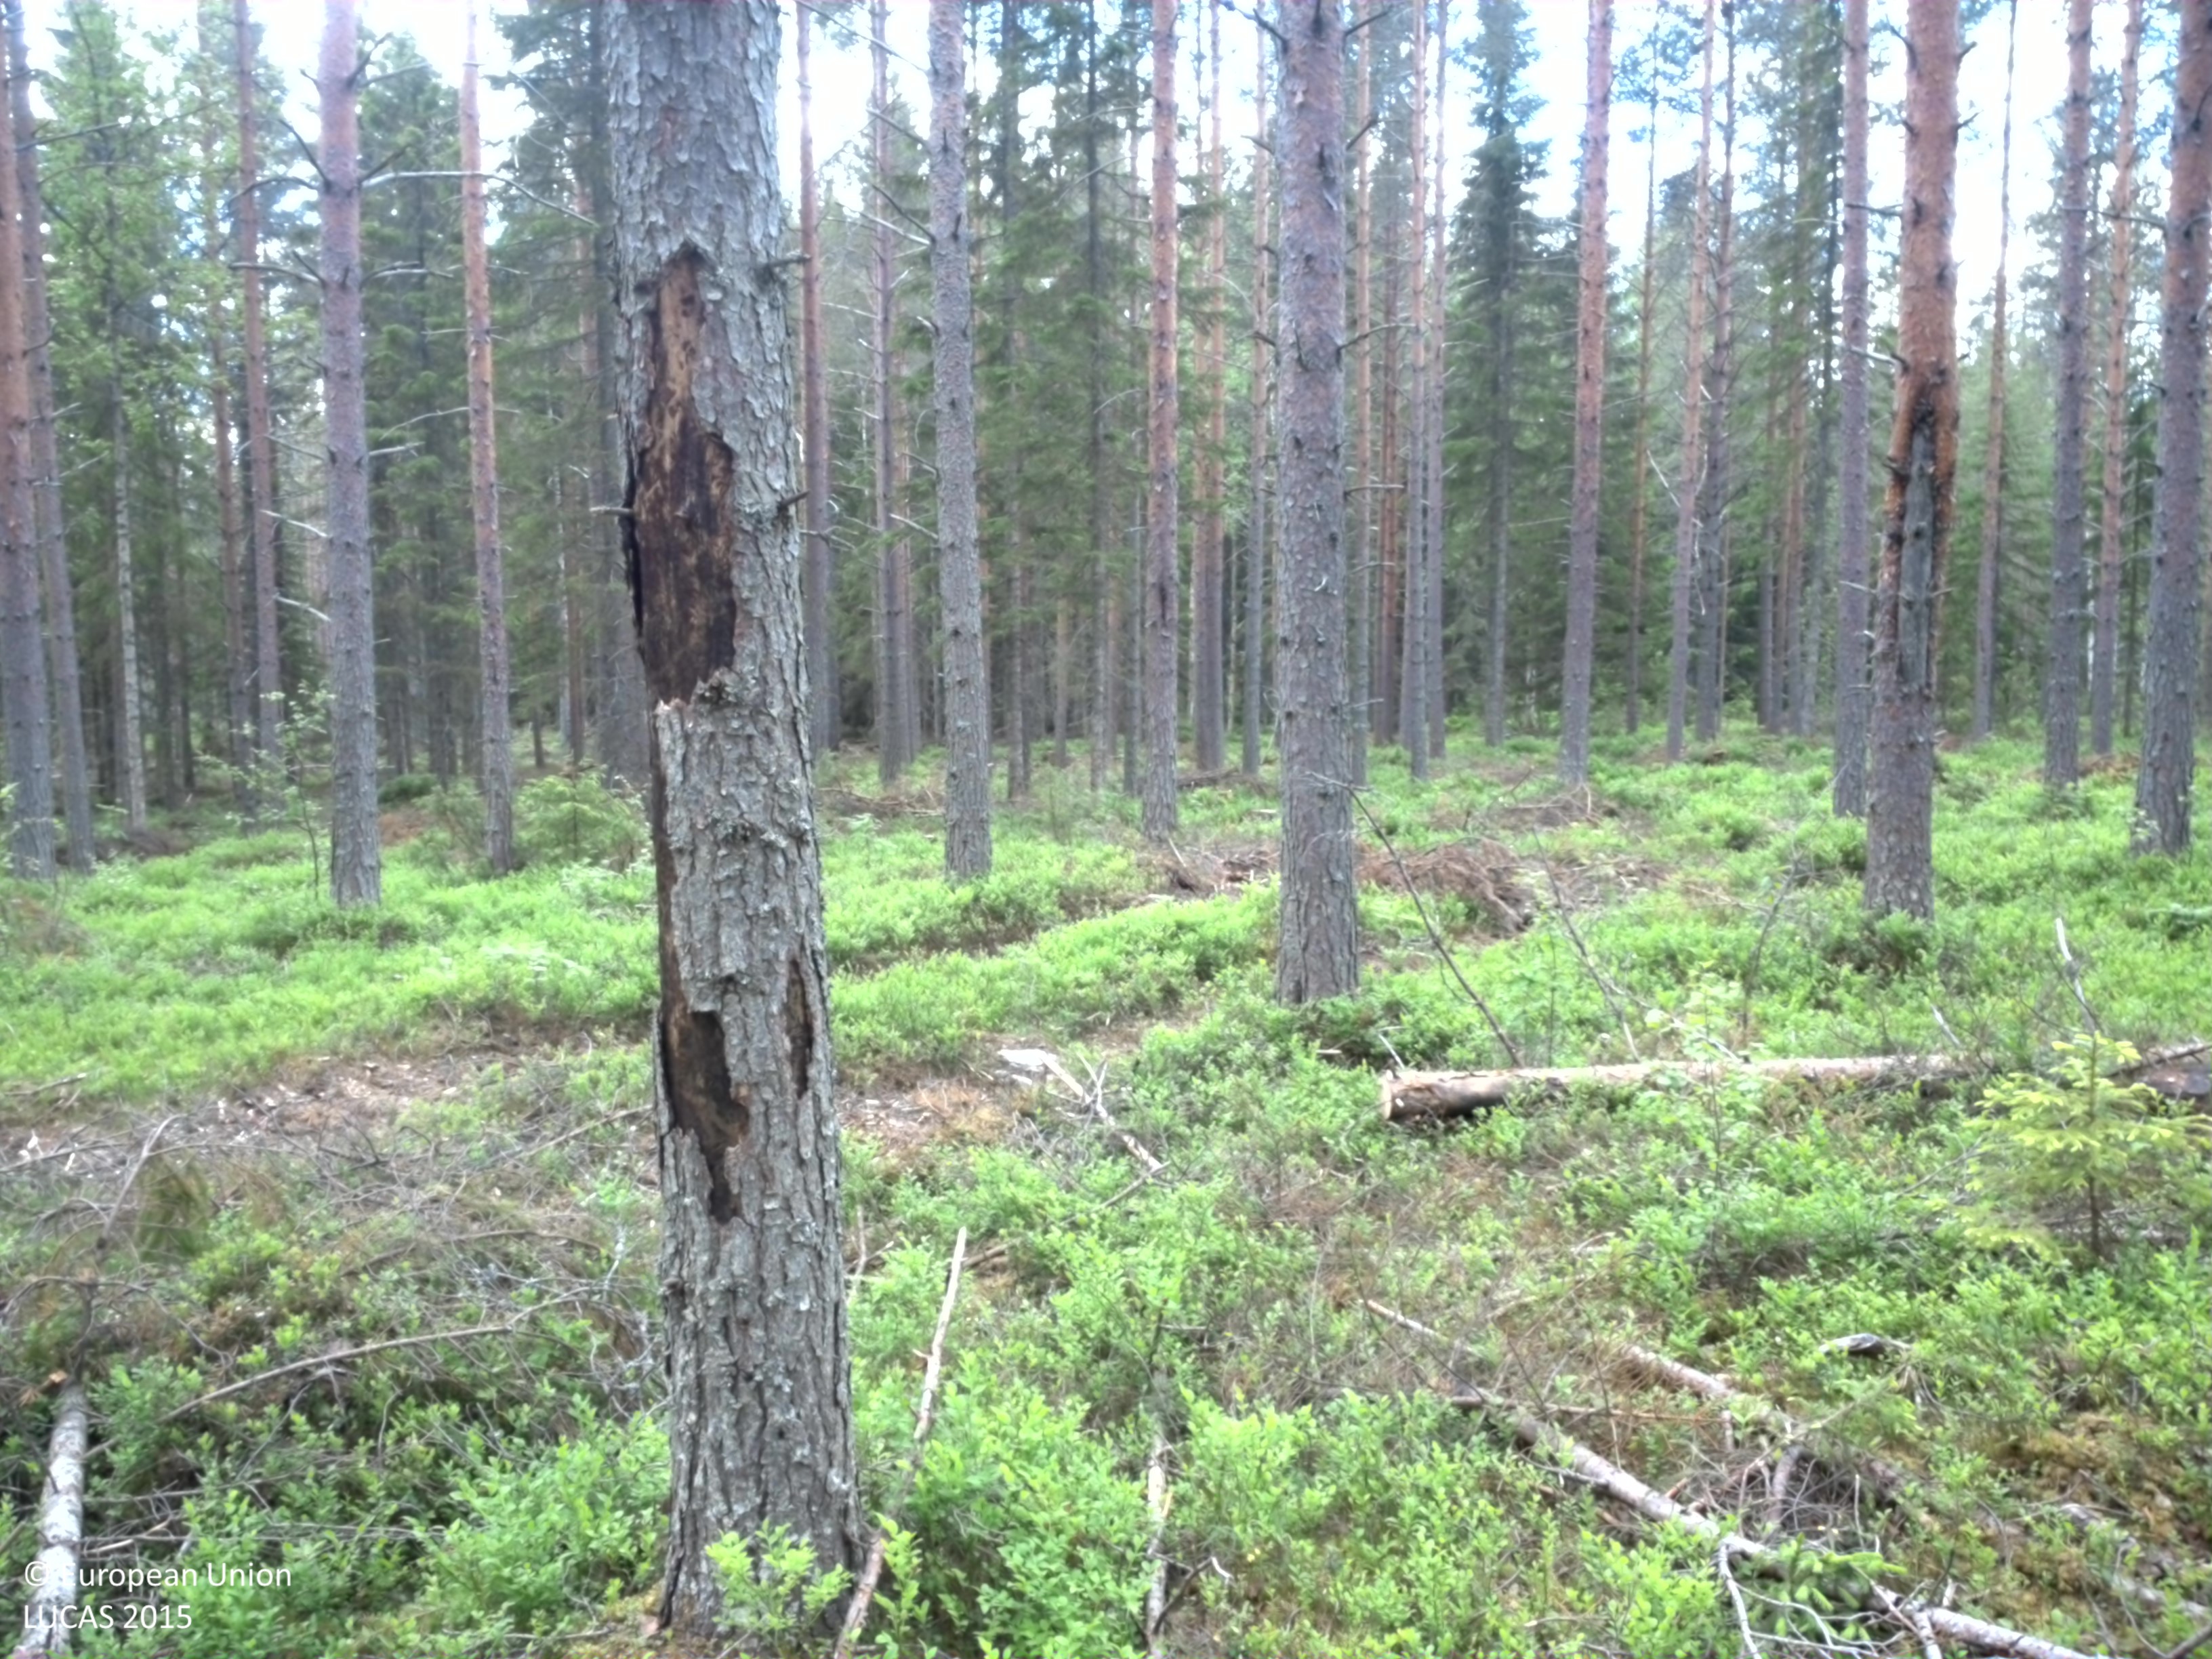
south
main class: Woodland
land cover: Pine dominated coniferous woodland
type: boreal forest
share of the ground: 50 - 75 %
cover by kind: coniferous forest trees 60 %, shrubs 40 %
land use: Forestry
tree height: > 5 m
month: July
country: SE
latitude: 64.3416
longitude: 20.7647
